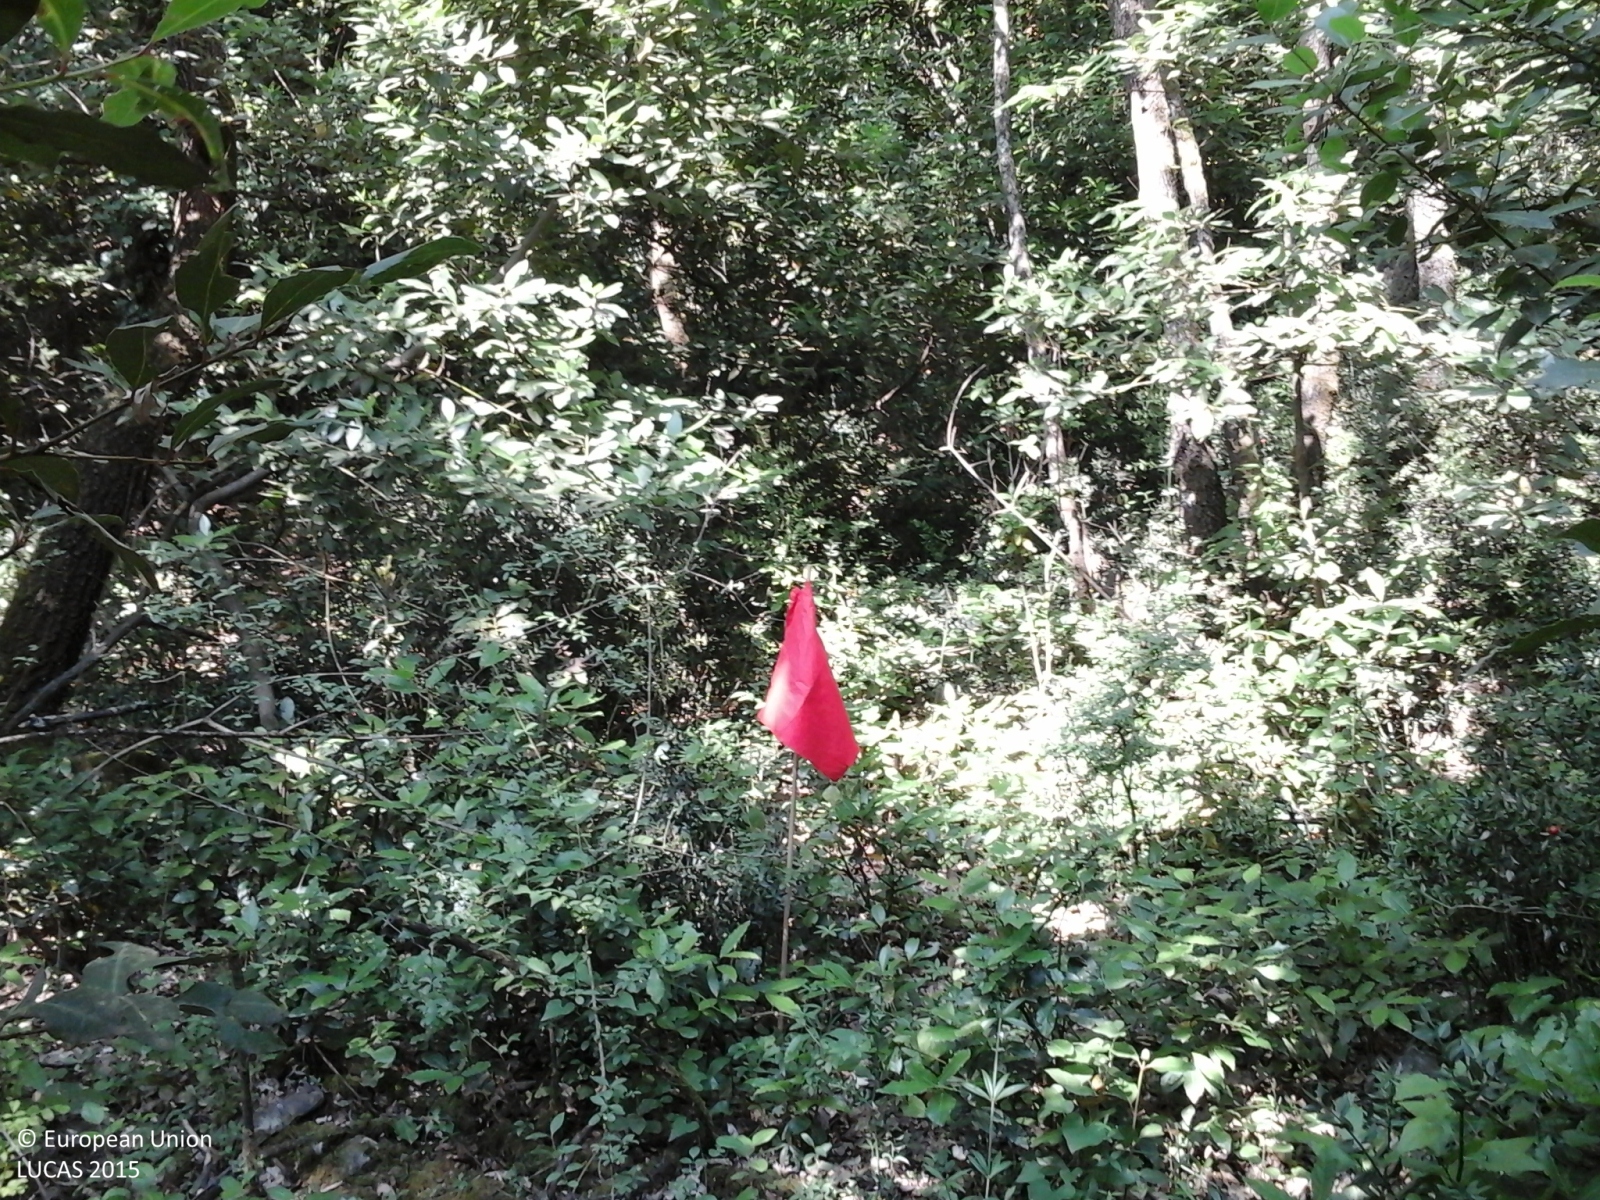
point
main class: Woodland
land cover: Other mixed woodland
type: thermophilous deciduous forest
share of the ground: > 75 %
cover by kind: broadleaved forest trees 50 %, coniferous forest trees 40 %, shrubs 10 %
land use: Forestry
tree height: > 5 m
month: June
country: IT
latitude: 43.8751
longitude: 11.1544
